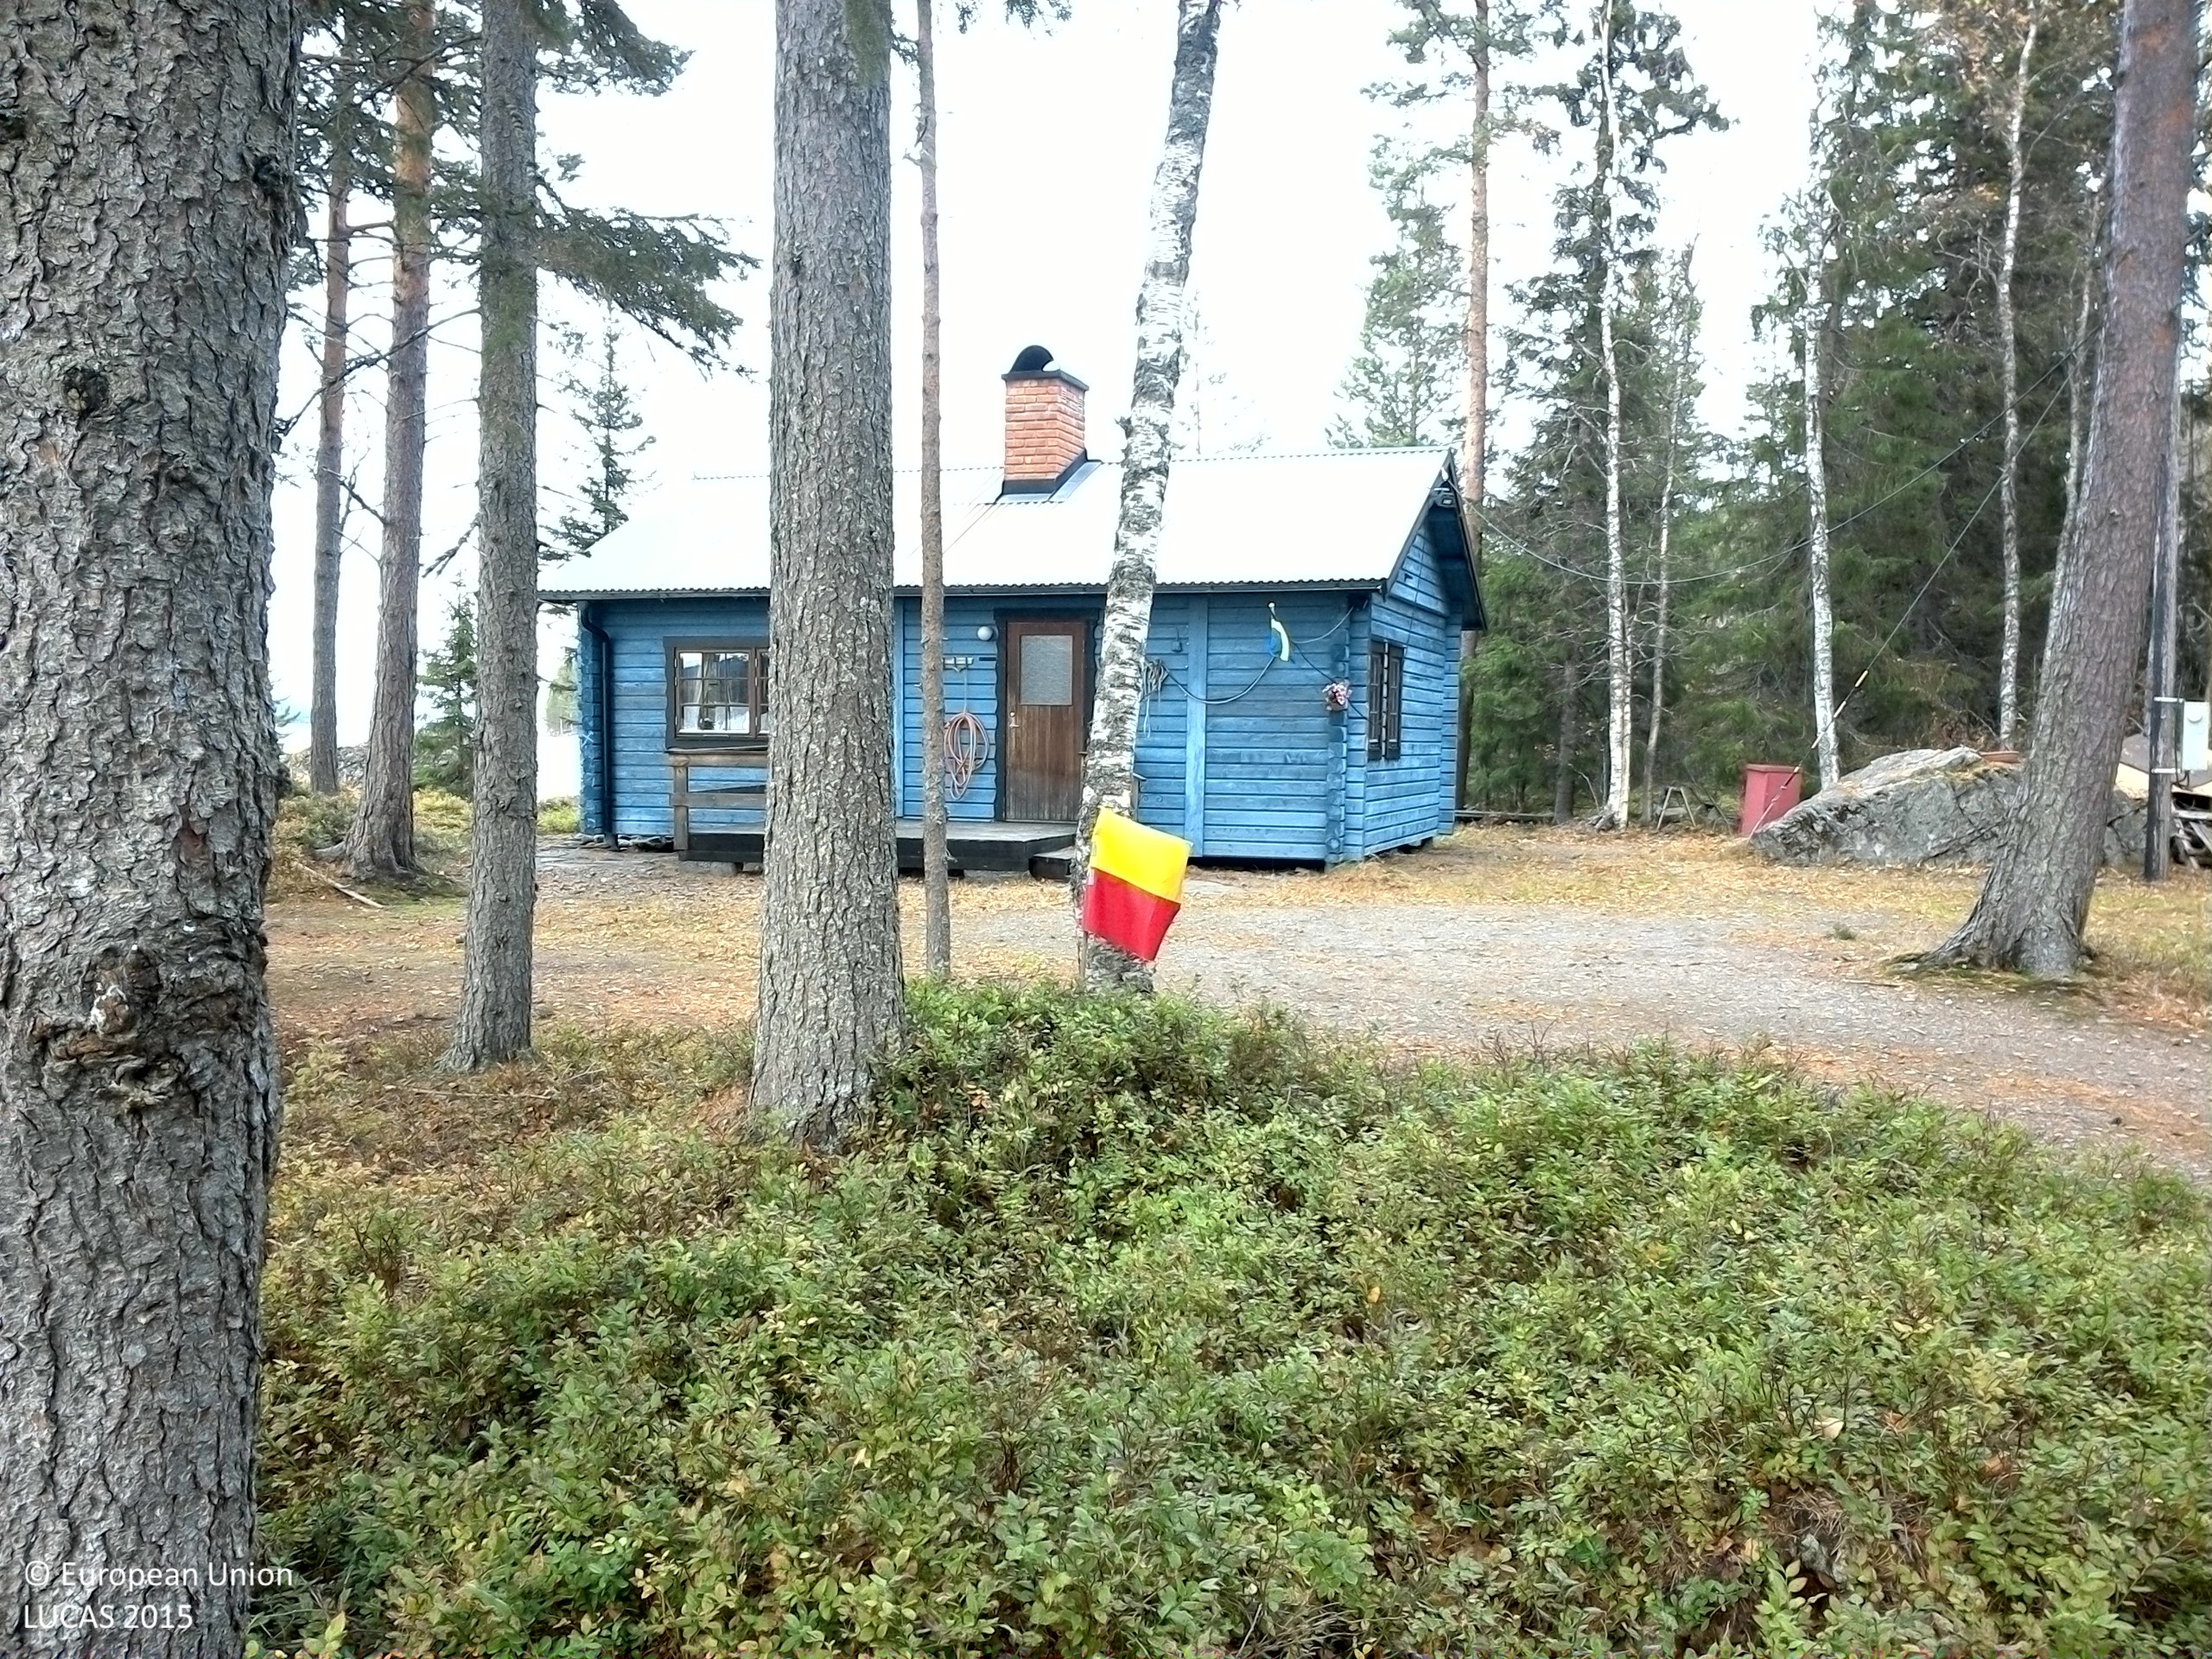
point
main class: Woodland
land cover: Pine dominated mixed woodland
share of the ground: 25 - 50 %
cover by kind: shrubs 50 %, coniferous forest trees 15 %, broadleaved forest trees 10 %, lichens and mosses 10 %, consolidated bare surface 5 %
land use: Residential
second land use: Forestry
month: October
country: SE
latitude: 64.0533
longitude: 15.8916
